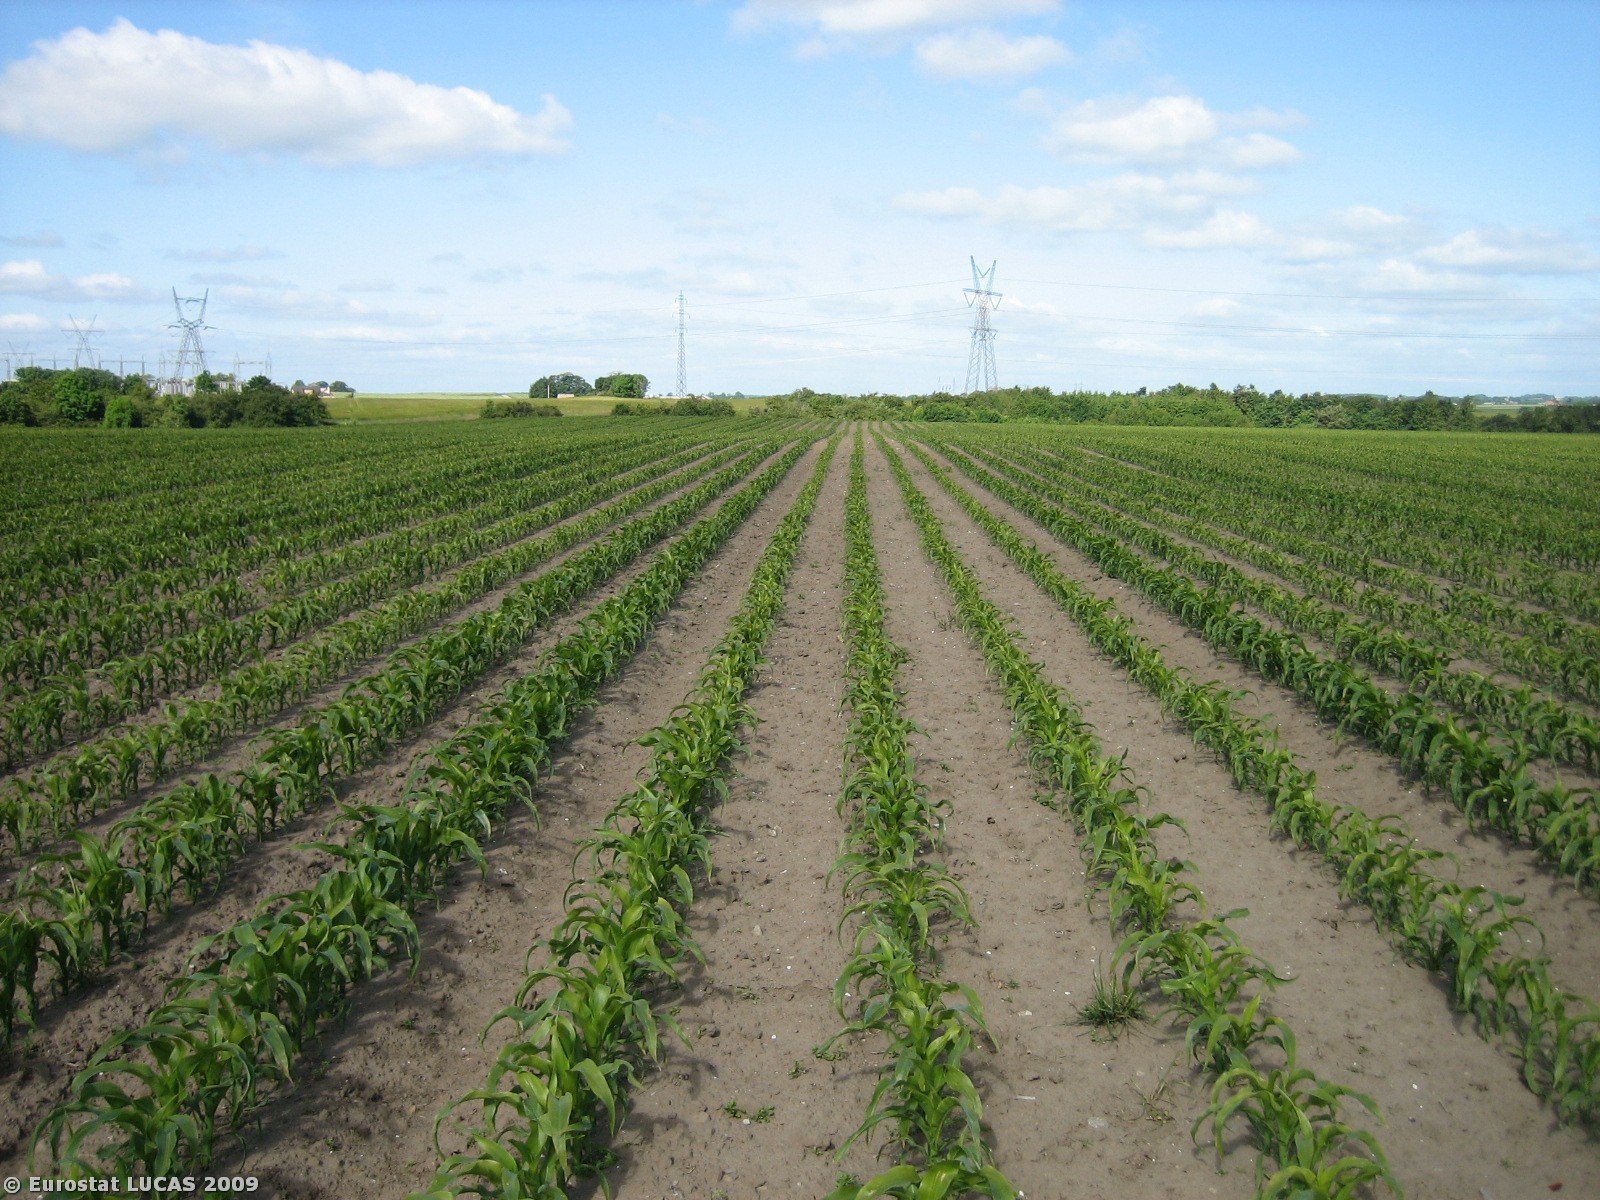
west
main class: Cropland
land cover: Maize
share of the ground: 10 - 25 %
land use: Agriculture (excluding fallow land and kitchen gardens)
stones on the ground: < 10 %
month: June
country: DK
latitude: 55.8640
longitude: 9.7606
